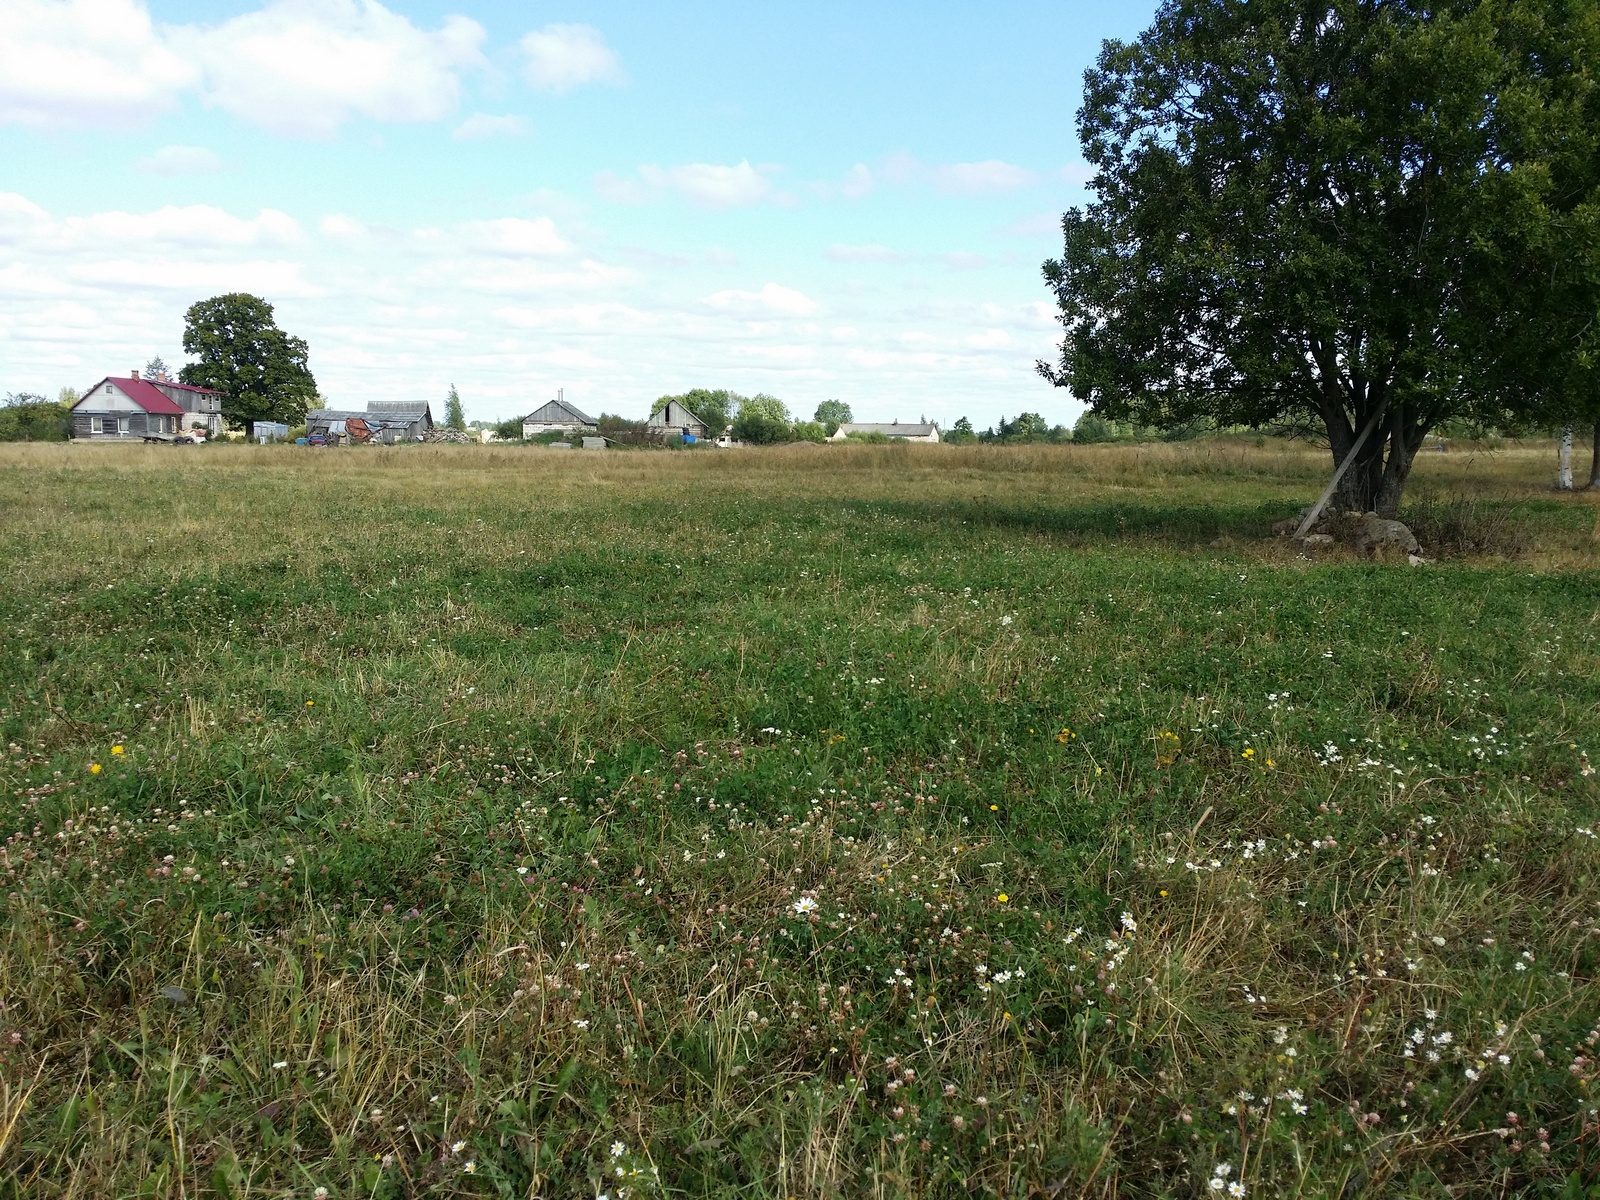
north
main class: Grassland
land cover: Grassland without tree/shrub cover
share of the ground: > 75 %
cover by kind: herbaceous plants 95 %, unconsolidated bare surface 5 %
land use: Agriculture (excluding fallow land and kitchen gardens)
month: August
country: LV
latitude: 57.2076
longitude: 27.7489
